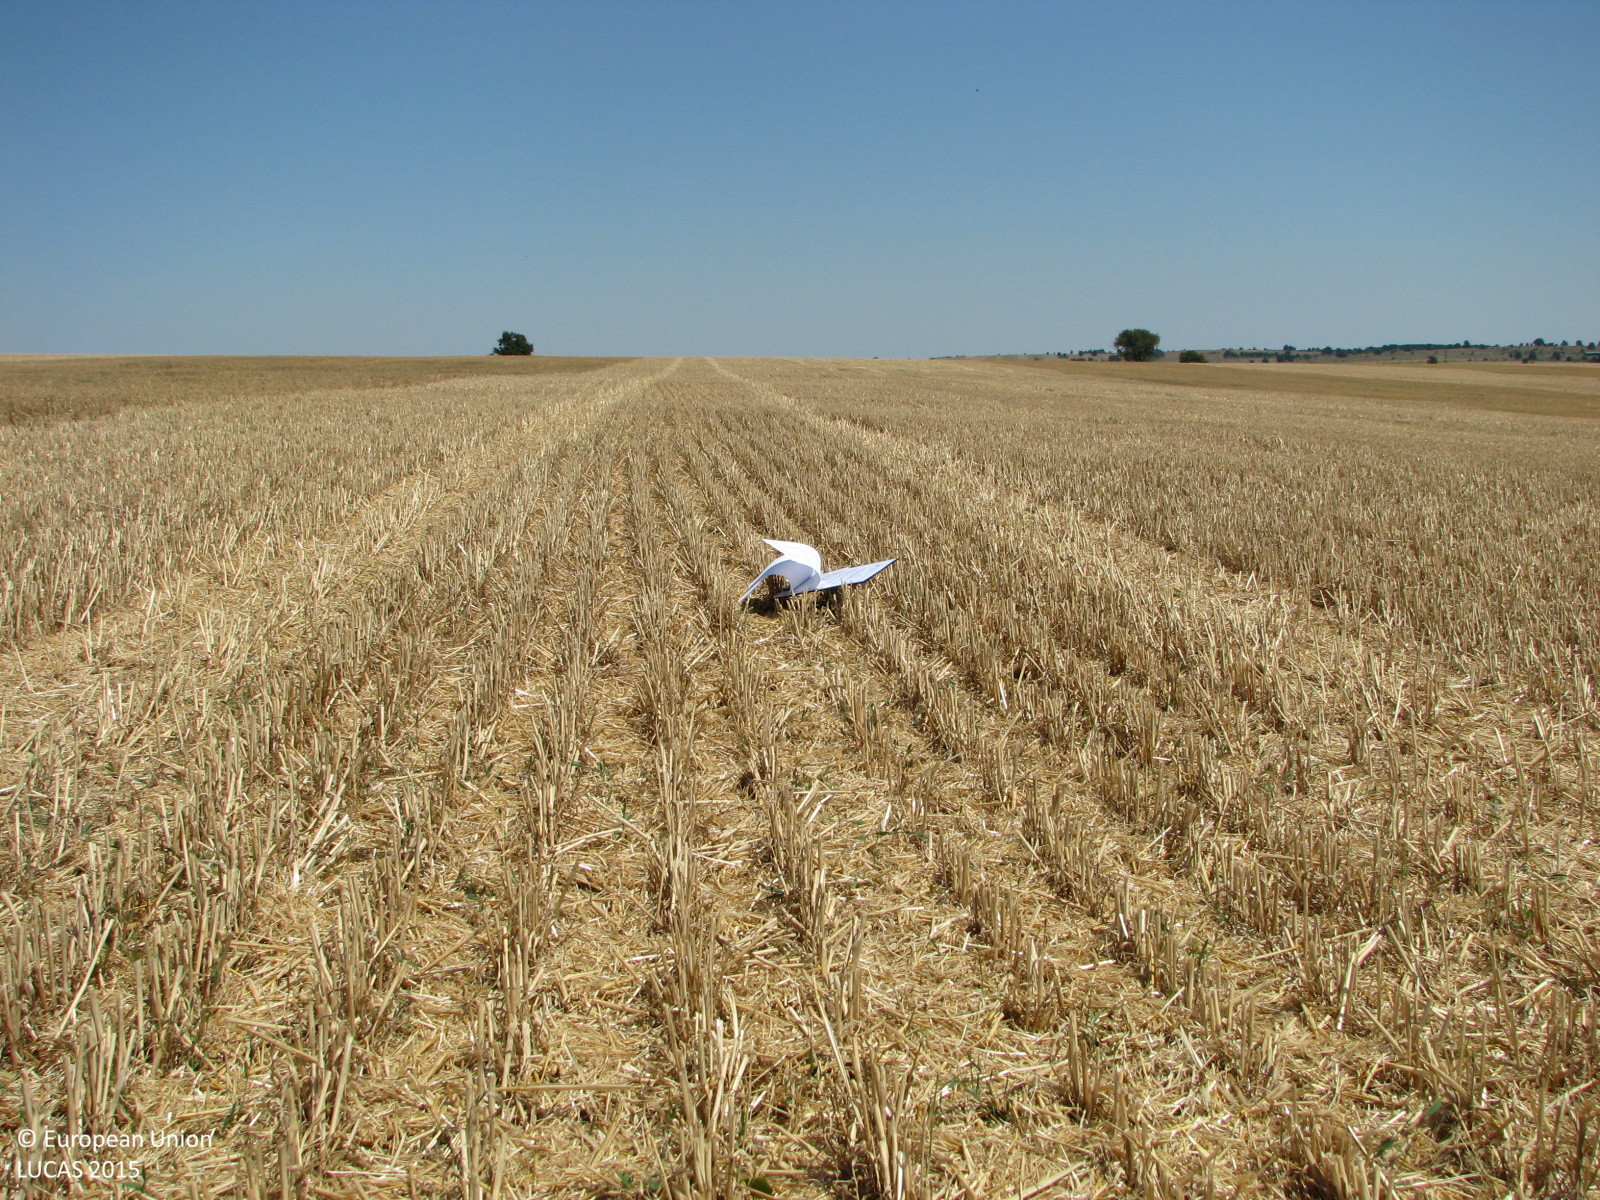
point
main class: Cropland
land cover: Common wheat
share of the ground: 25 - 50 %
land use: Agriculture (excluding fallow land and kitchen gardens)
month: July
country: BG
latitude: 42.1889
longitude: 26.8428
